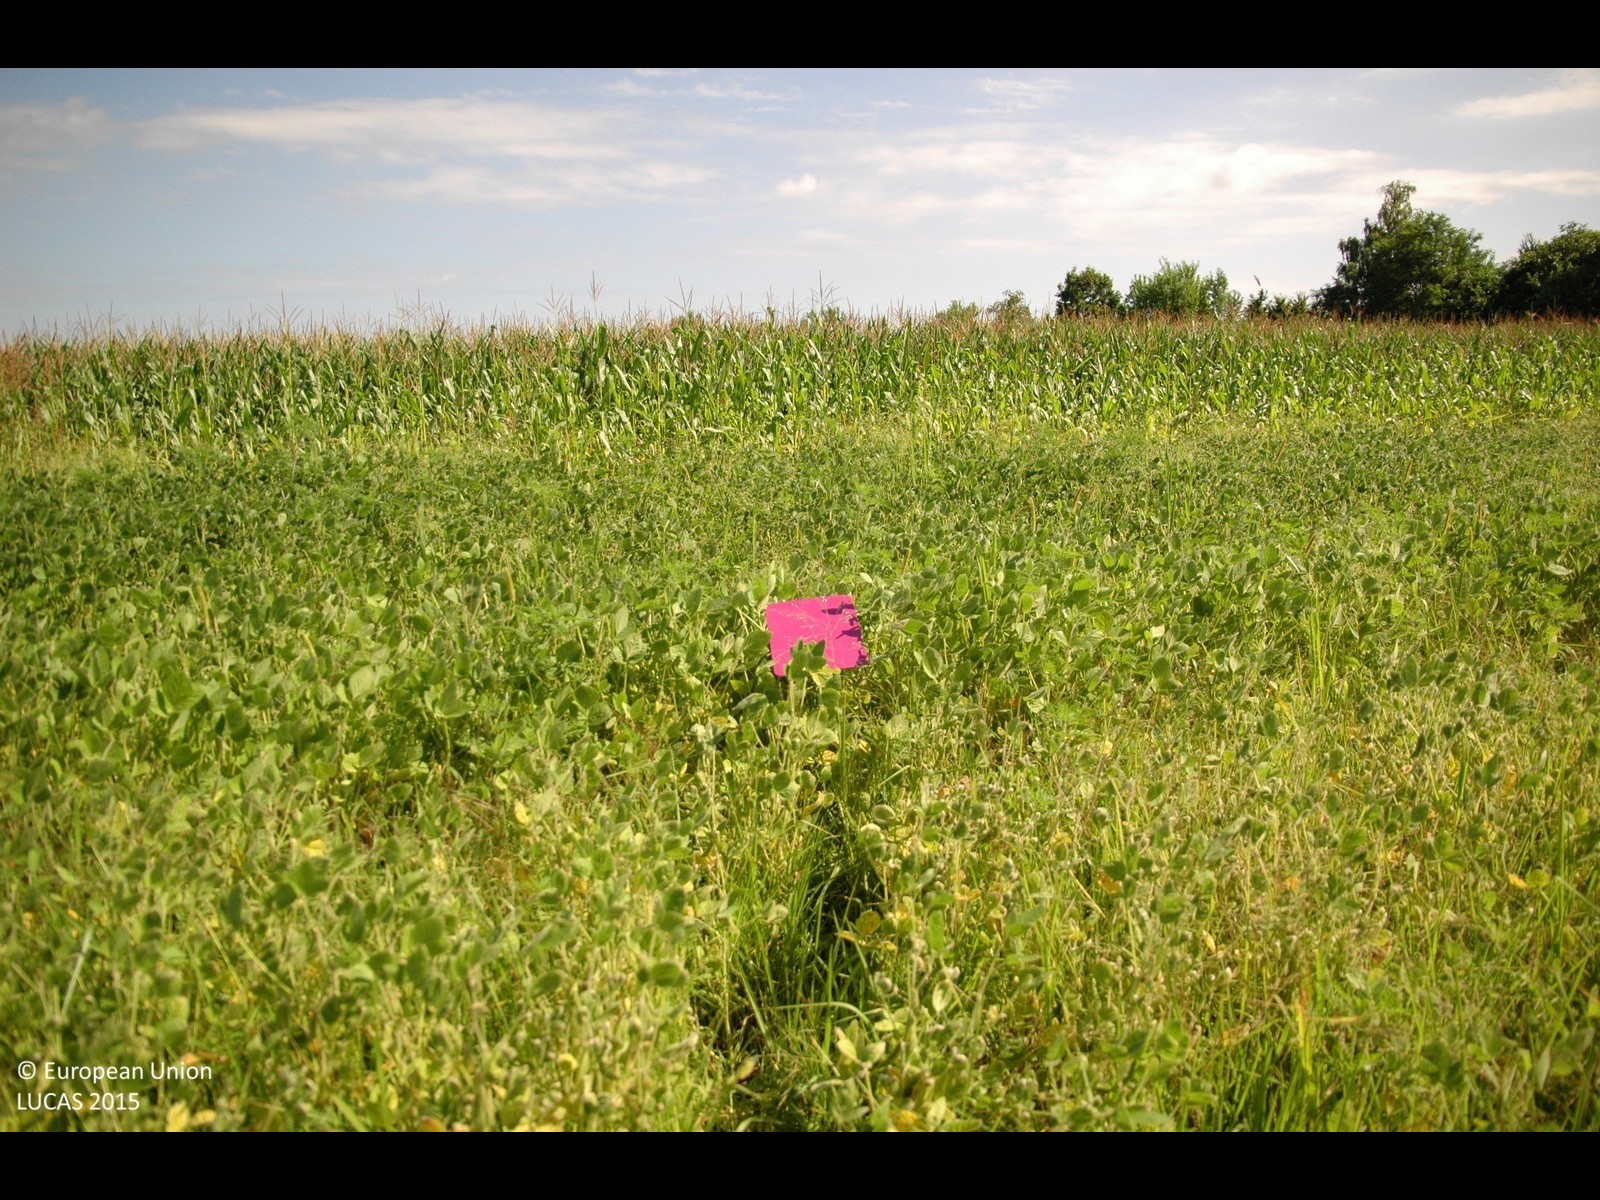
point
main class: Cropland
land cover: Soya
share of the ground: > 75 %
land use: Agriculture (excluding fallow land and kitchen gardens)
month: July
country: HR
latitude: 46.2132
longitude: 16.7025
